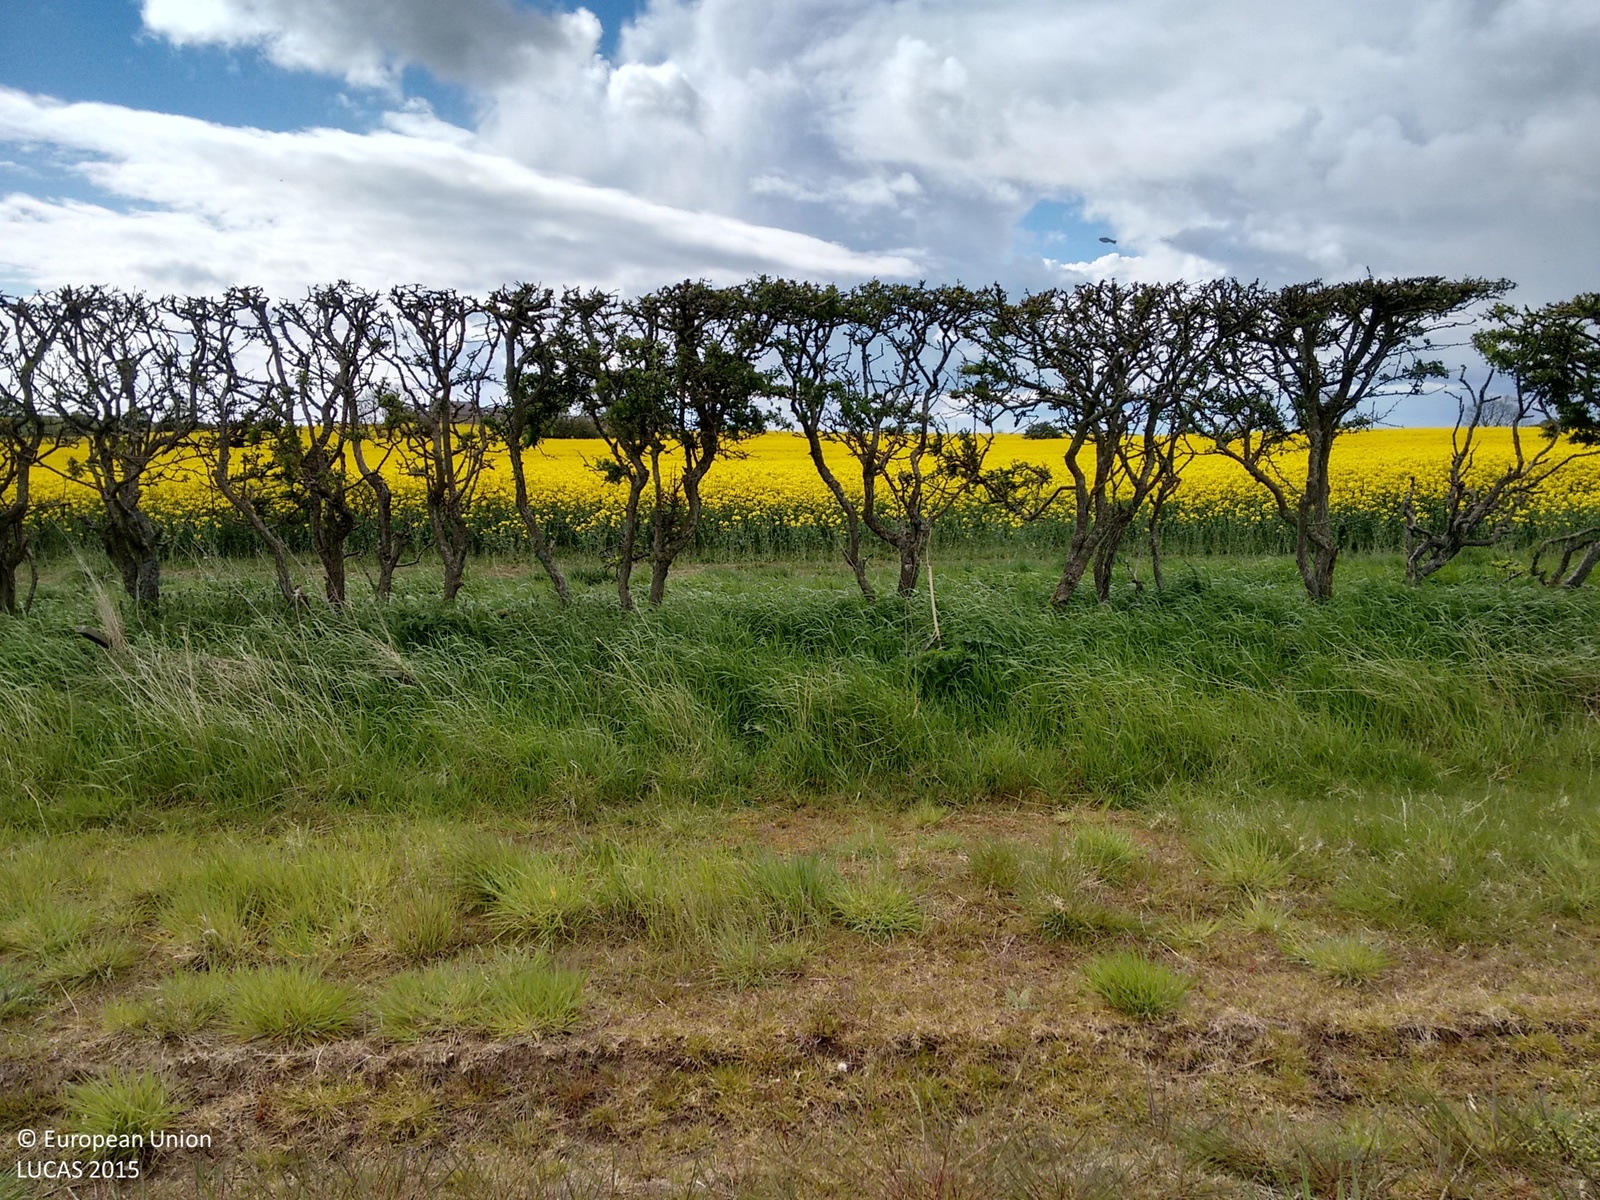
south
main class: Cropland
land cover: Common wheat
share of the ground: > 75 %
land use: Agriculture (excluding fallow land and kitchen gardens)
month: May
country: GB
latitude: 55.3675
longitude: -1.6128
